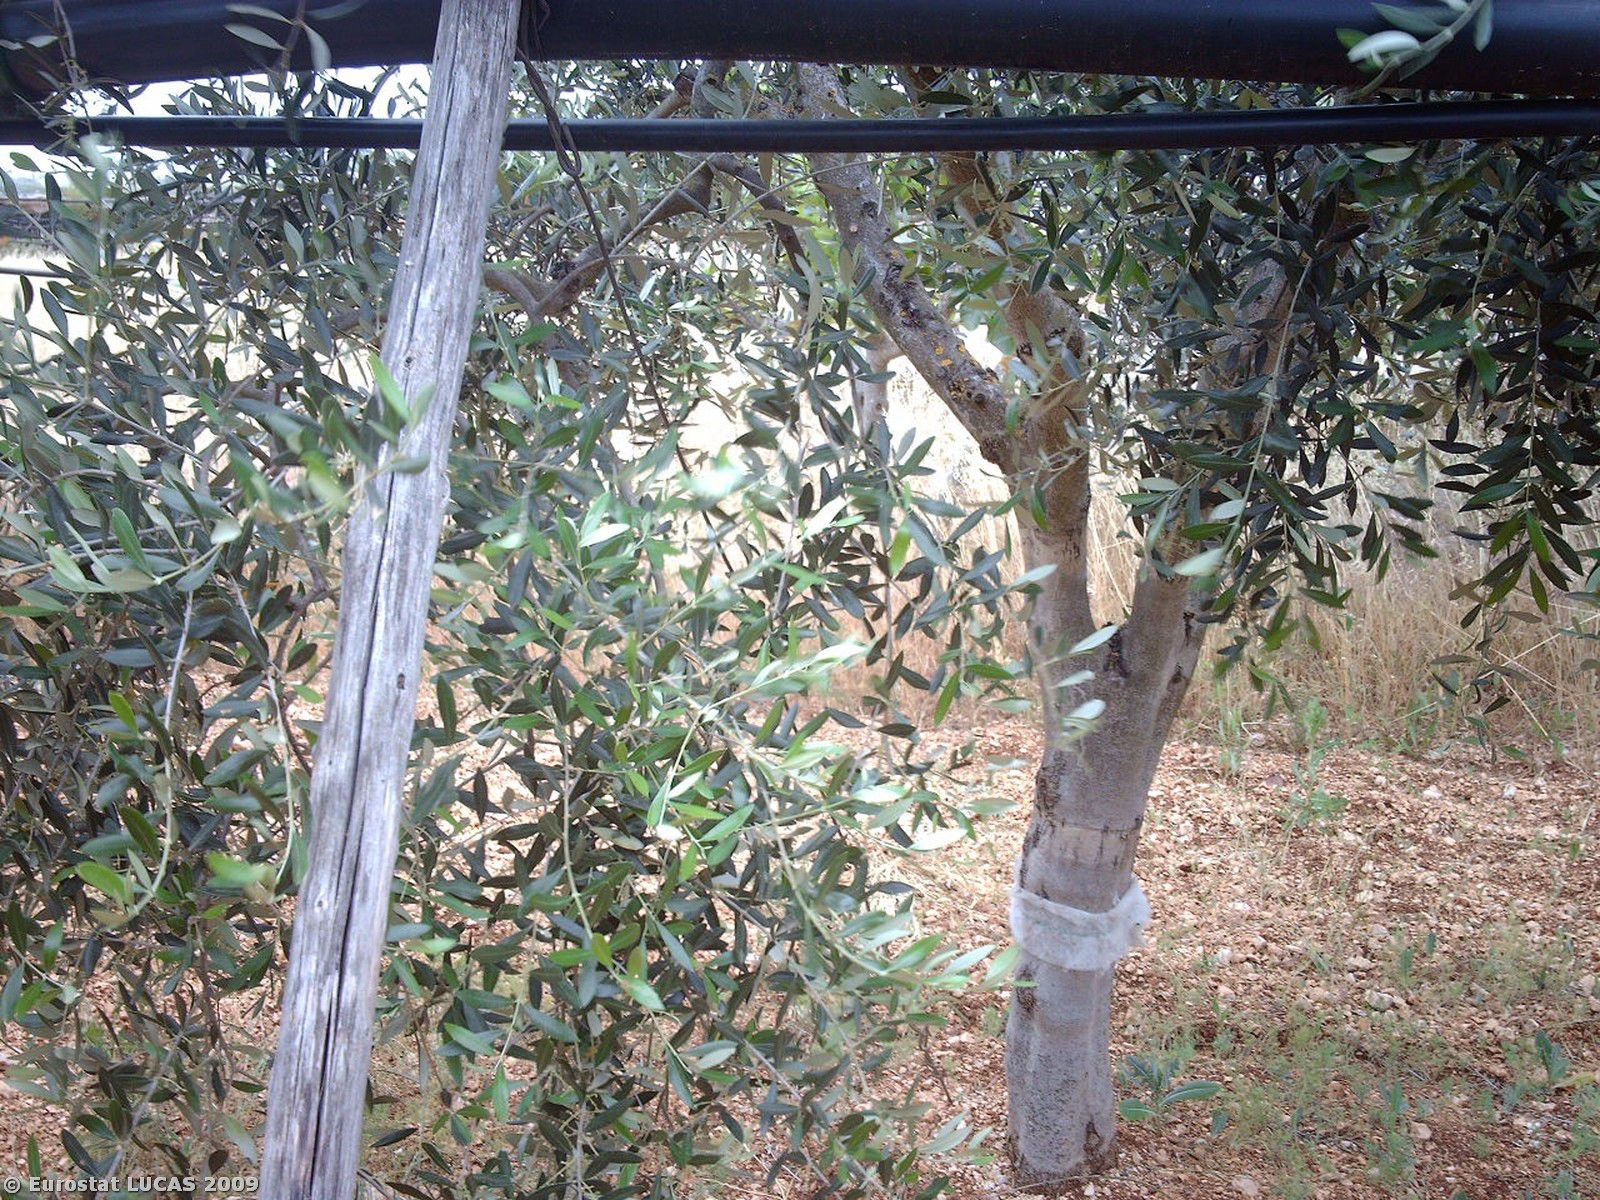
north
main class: Cropland
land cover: Cherry fruit
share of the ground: 25 - 50 %
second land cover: Olive groves
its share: 10 - 25 %
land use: Agriculture (excluding fallow land and kitchen gardens)
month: June
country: IT
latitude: 40.9936
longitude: 17.0517
